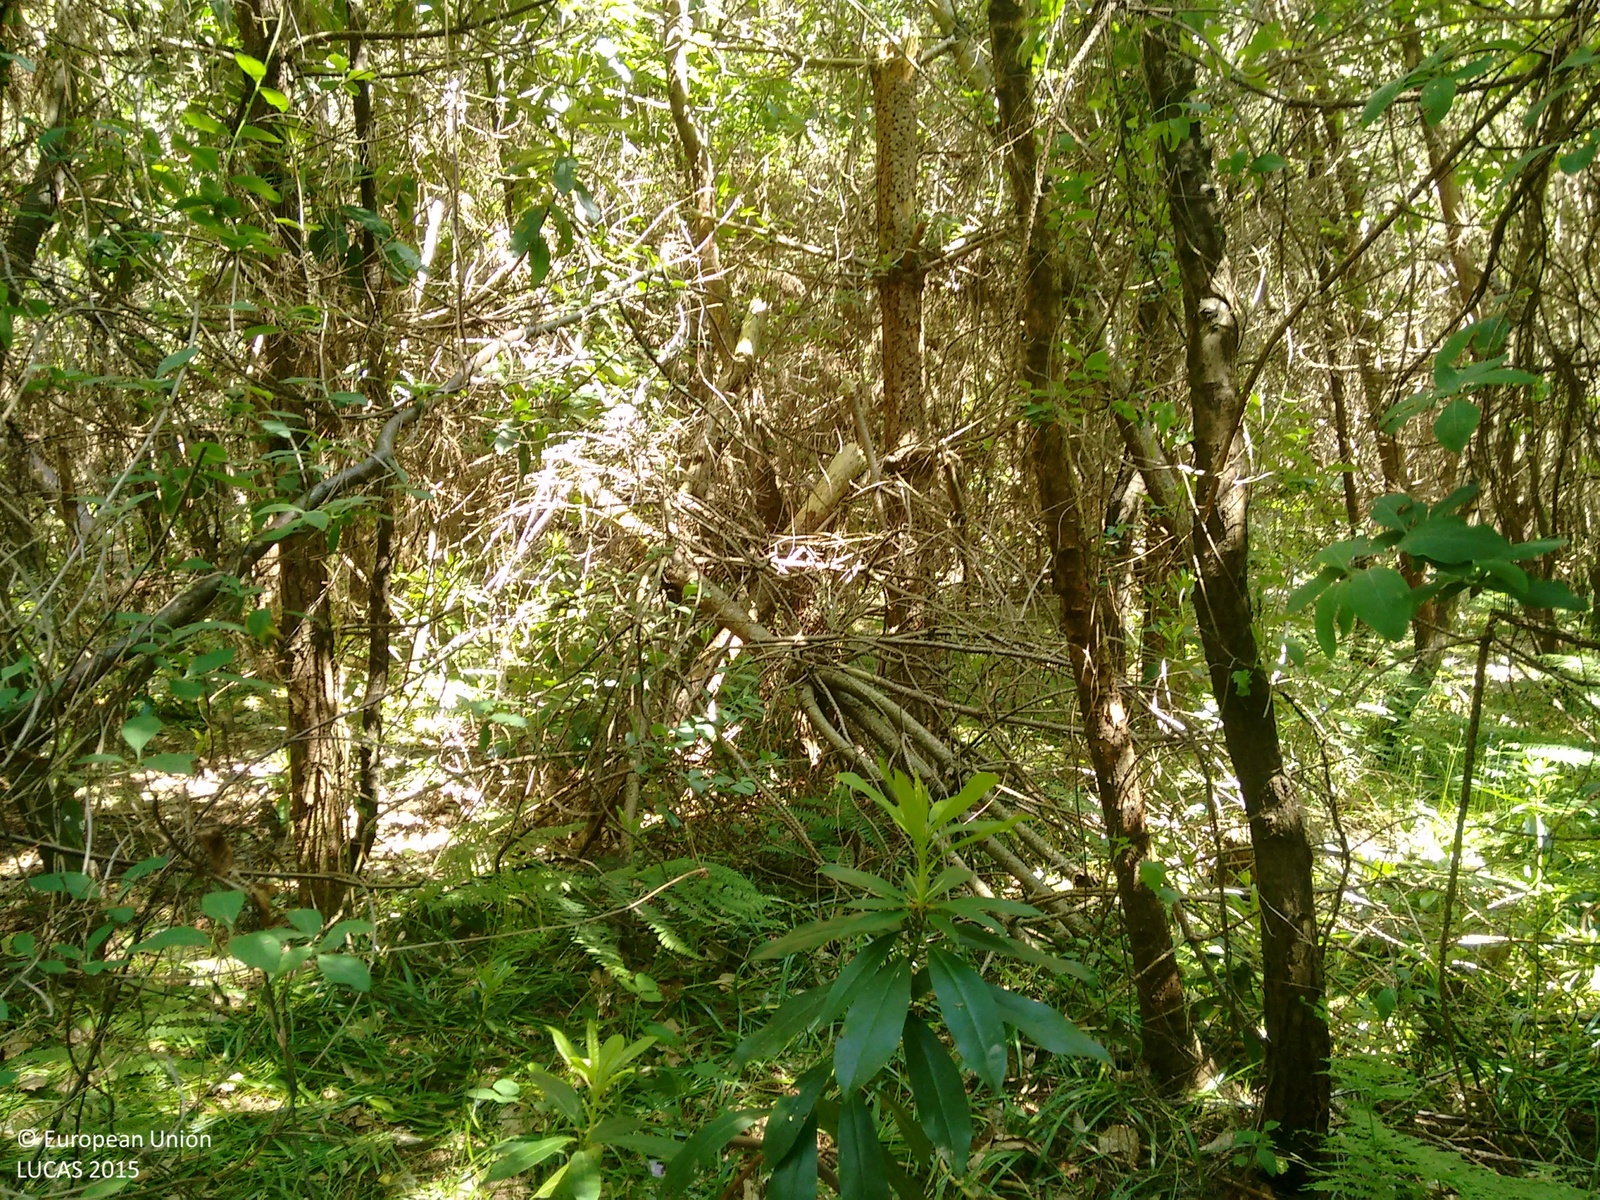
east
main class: Woodland
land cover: Other mixed woodland
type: exotic forest
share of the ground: > 75 %
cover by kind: coniferous forest trees 70 %, broadleaved forest trees 30 %
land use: Forestry
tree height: > 5 m
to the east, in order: Other mixed woodland; Pine dominated coniferous woodland; Tracks; Pine dominated coniferous woodland
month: June
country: GB
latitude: 51.0708
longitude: 0.4814
